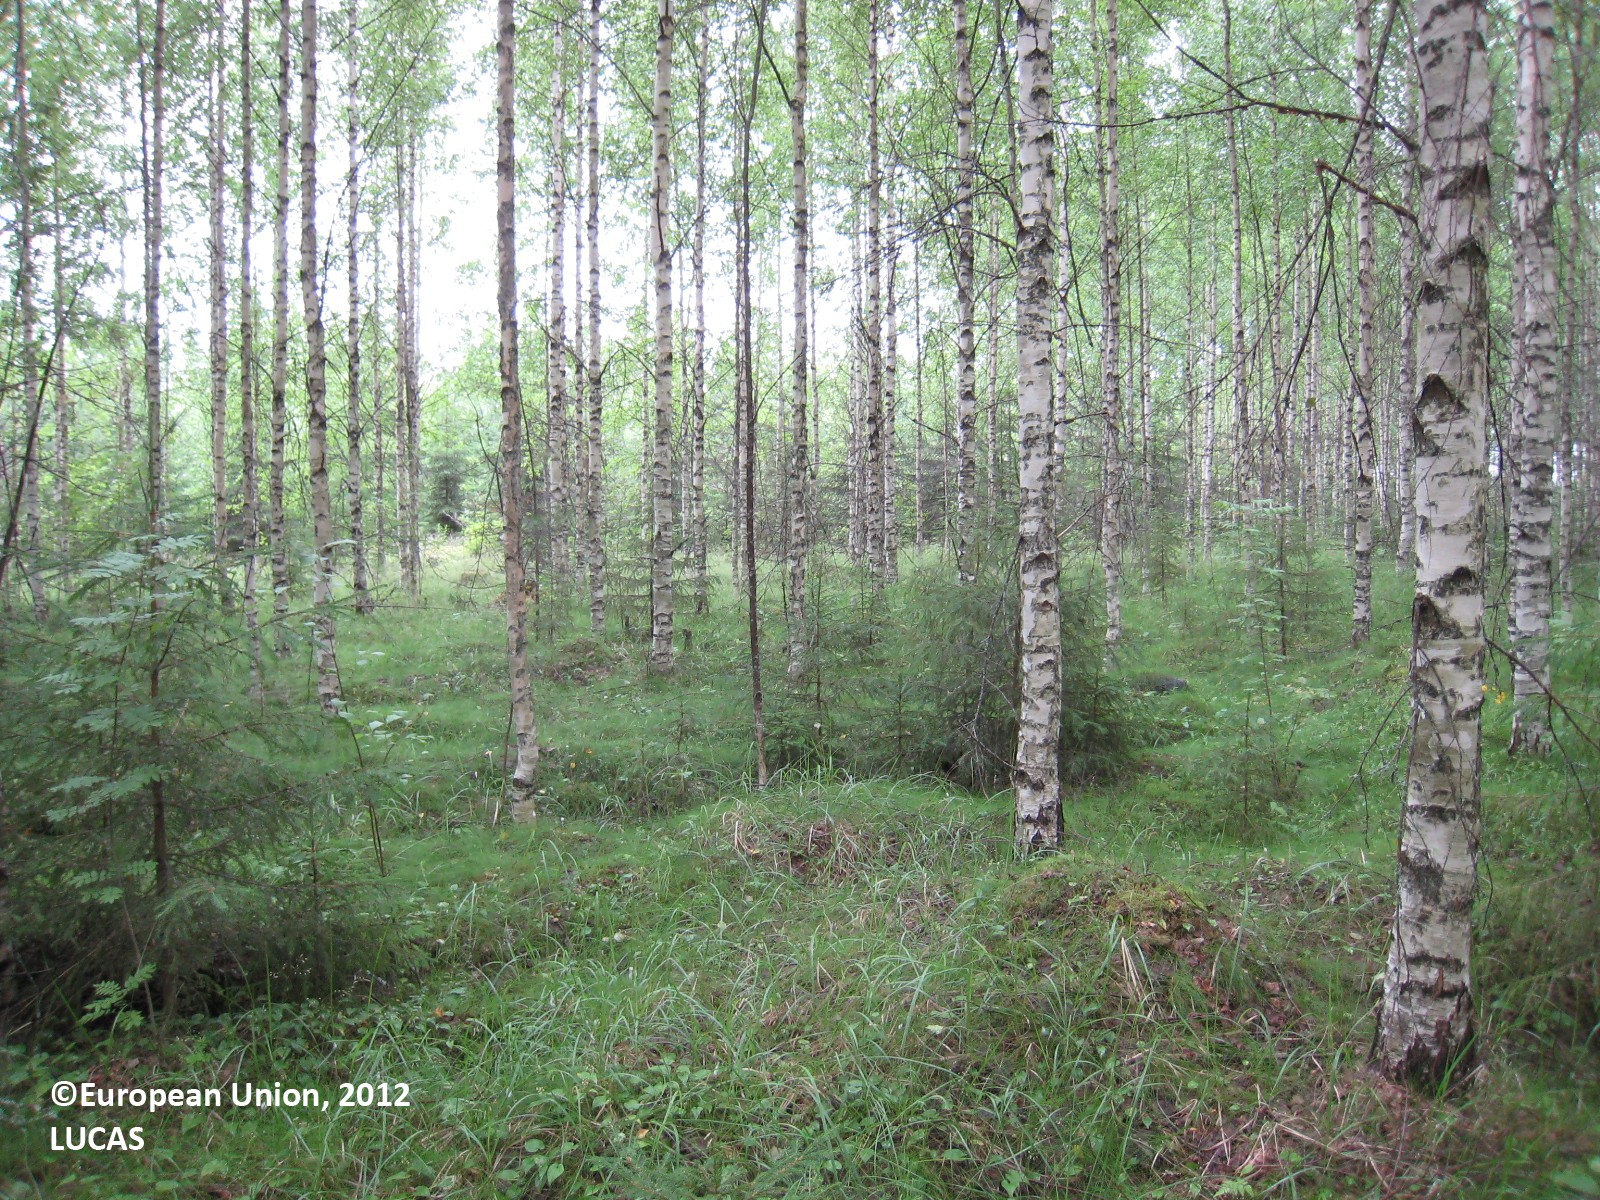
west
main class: Woodland
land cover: Broadleaved woodland
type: non-riverine alder, birch or aspen forest
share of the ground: > 75 %
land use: Forestry
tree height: > 5 m
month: July
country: FI
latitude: 61.7415
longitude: 27.3430
